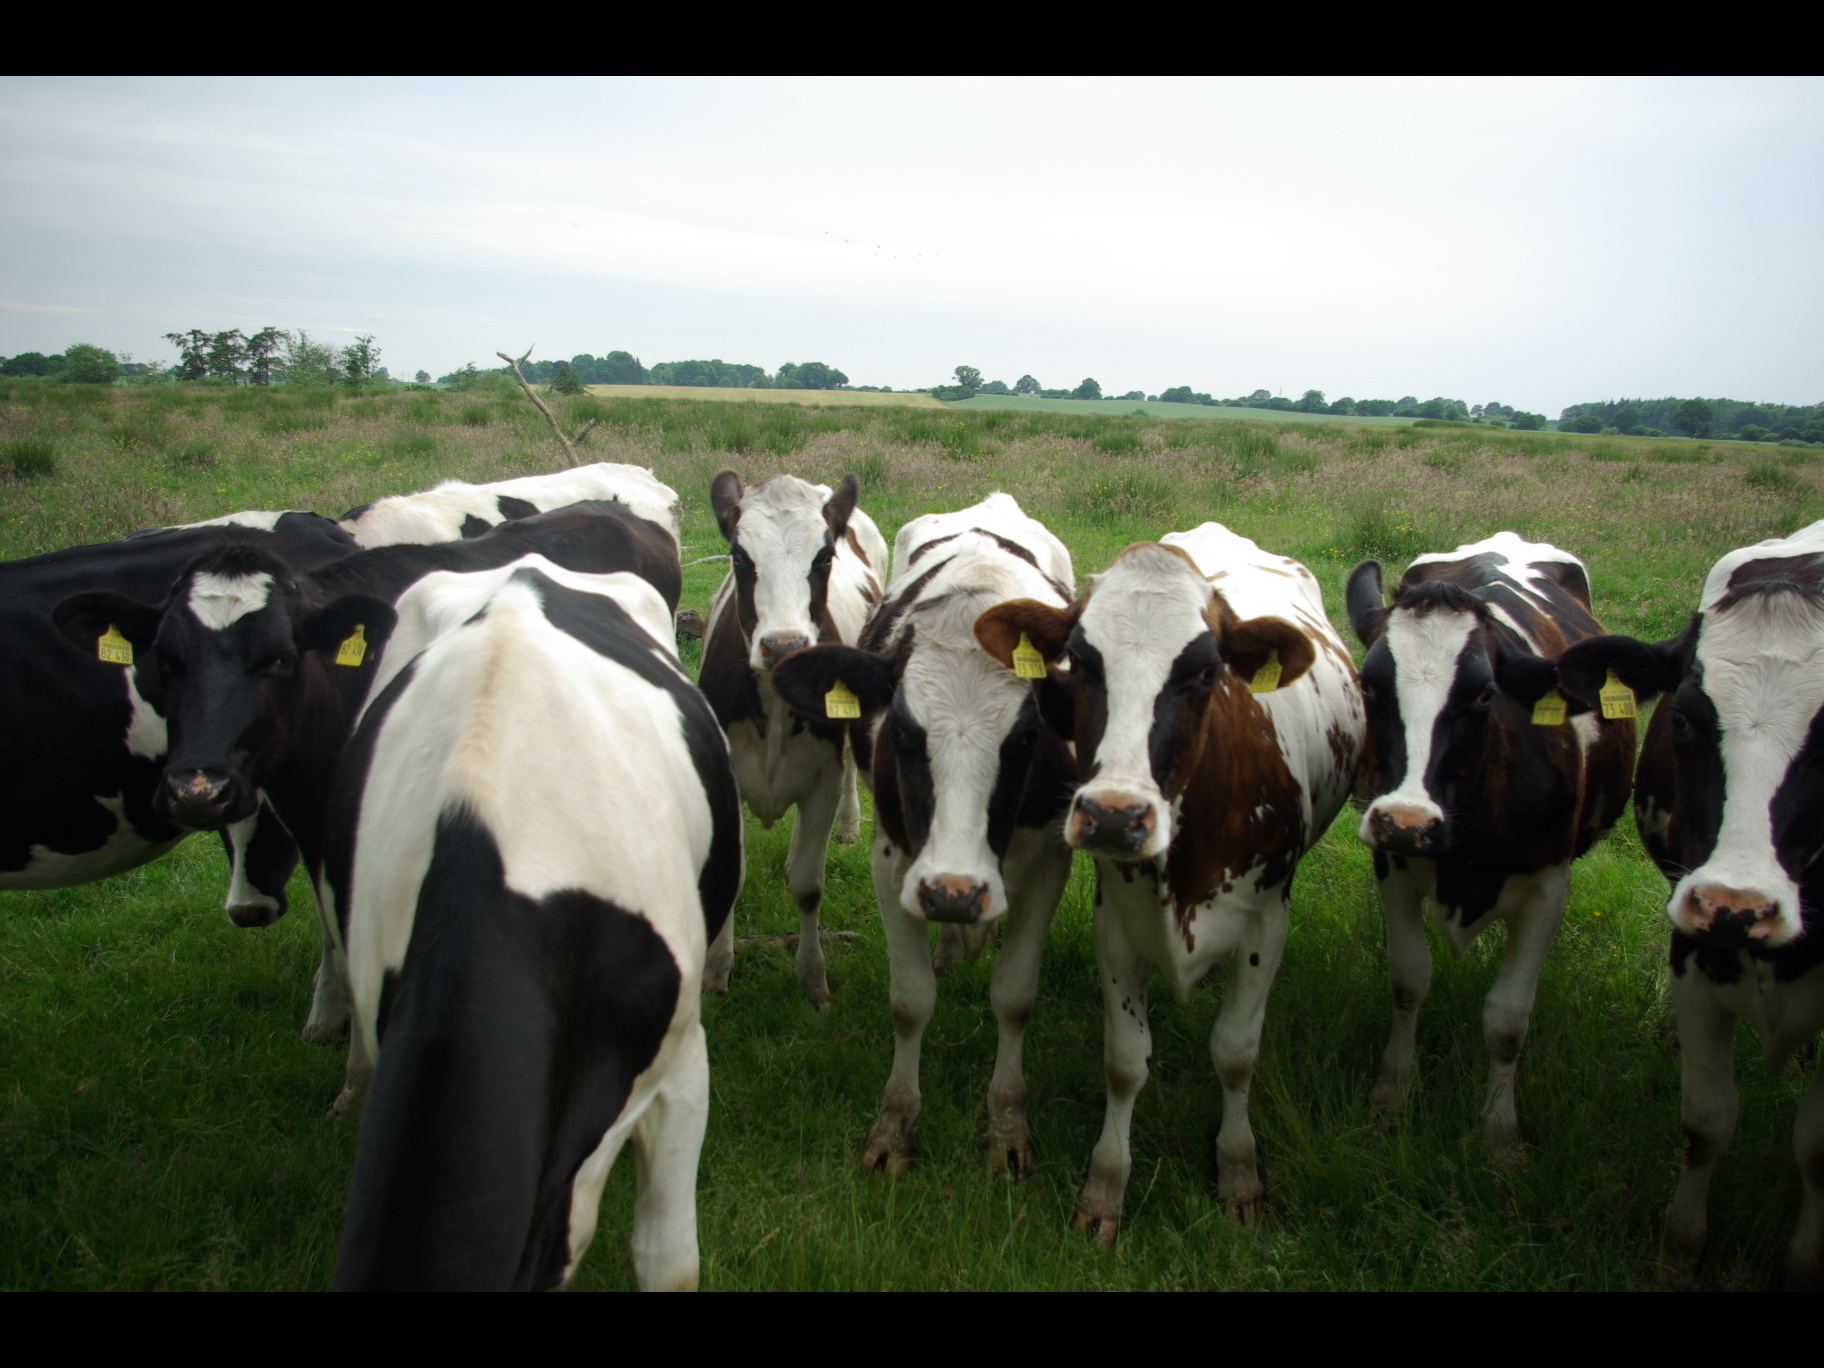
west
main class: Grassland
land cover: Grassland without tree/shrub cover
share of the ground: > 75 %
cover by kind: herbaceous plants 100 %
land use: Agriculture (excluding fallow land and kitchen gardens)
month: June
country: DE
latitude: 54.5341
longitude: 9.8919
